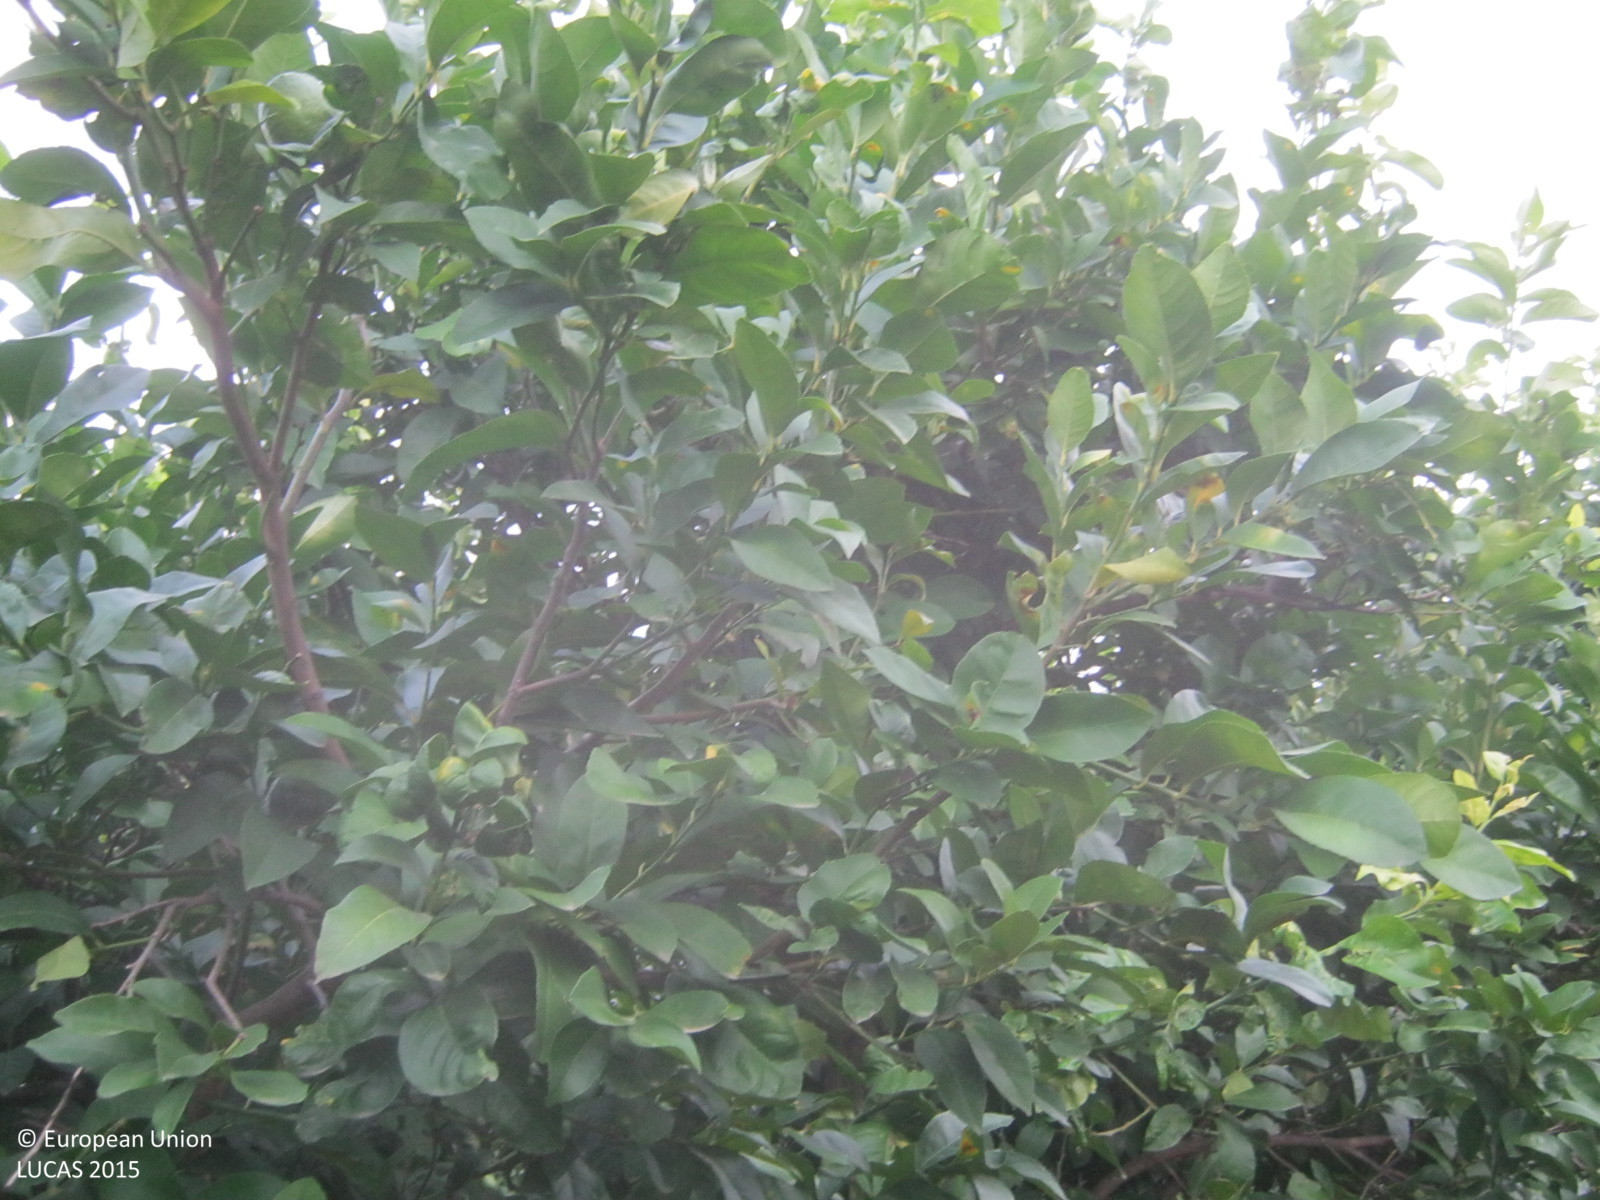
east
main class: Cropland
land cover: Other citrus fruit
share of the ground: 50 - 75 %
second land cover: Spontaneously vegetated surfaces
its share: > 75 %
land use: Agriculture (excluding fallow land and kitchen gardens)
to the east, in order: Other citrus fruit; Spontaneously vegetated surfaces; Tracks; Shrubland without tree cover; Railways; Shrubland without tree cover; Tracks; Fences; Other citrus fruit; Electric lines; Other citrus fruit; Broadleaved woodland; Oranges; Paved roads, cycling and walking lanes; Other citrus fruit; Fences; Oranges; Other citrus fruit
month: September
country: GR
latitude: 38.2306
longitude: 22.1363
